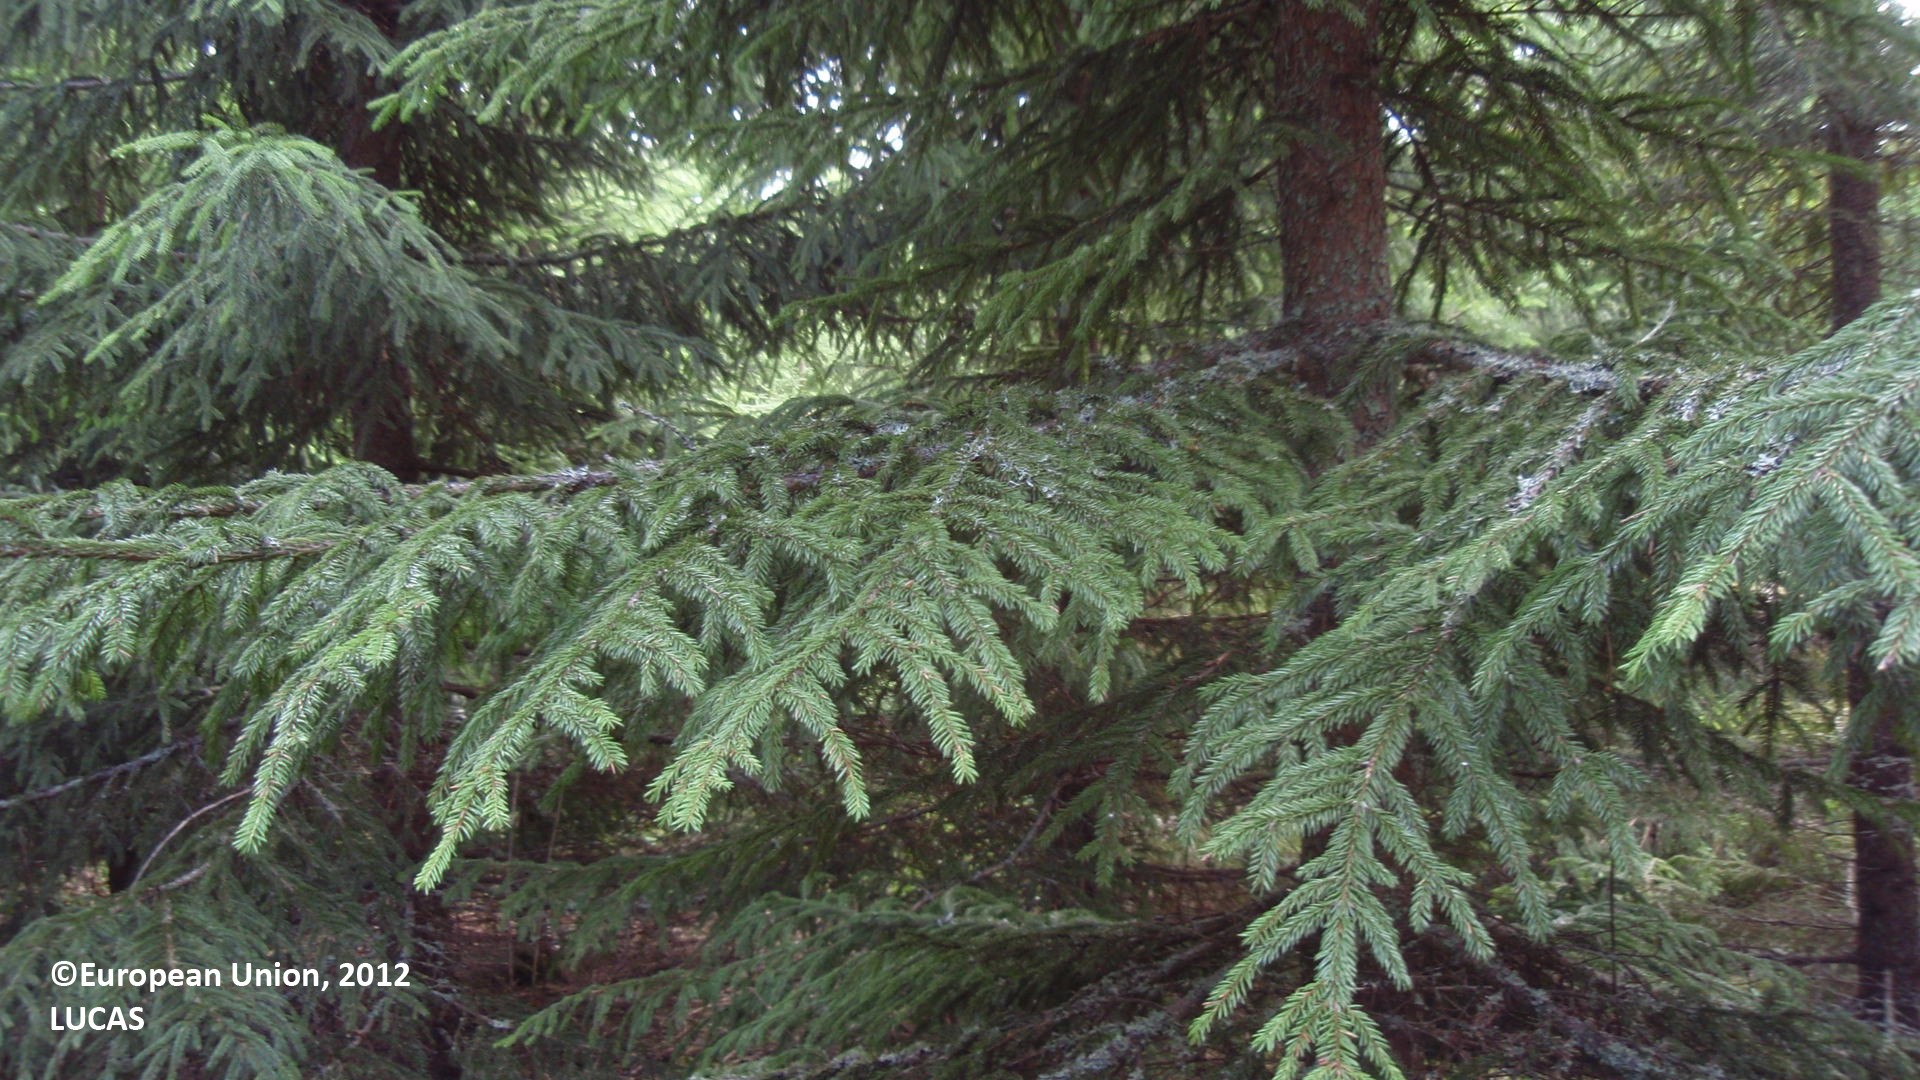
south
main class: Woodland
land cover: Spruce dominated coniferous woodland
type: boreal forest
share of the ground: > 75 %
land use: Forestry
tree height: > 5 m
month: August
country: FI
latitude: 61.0461
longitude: 26.9605
